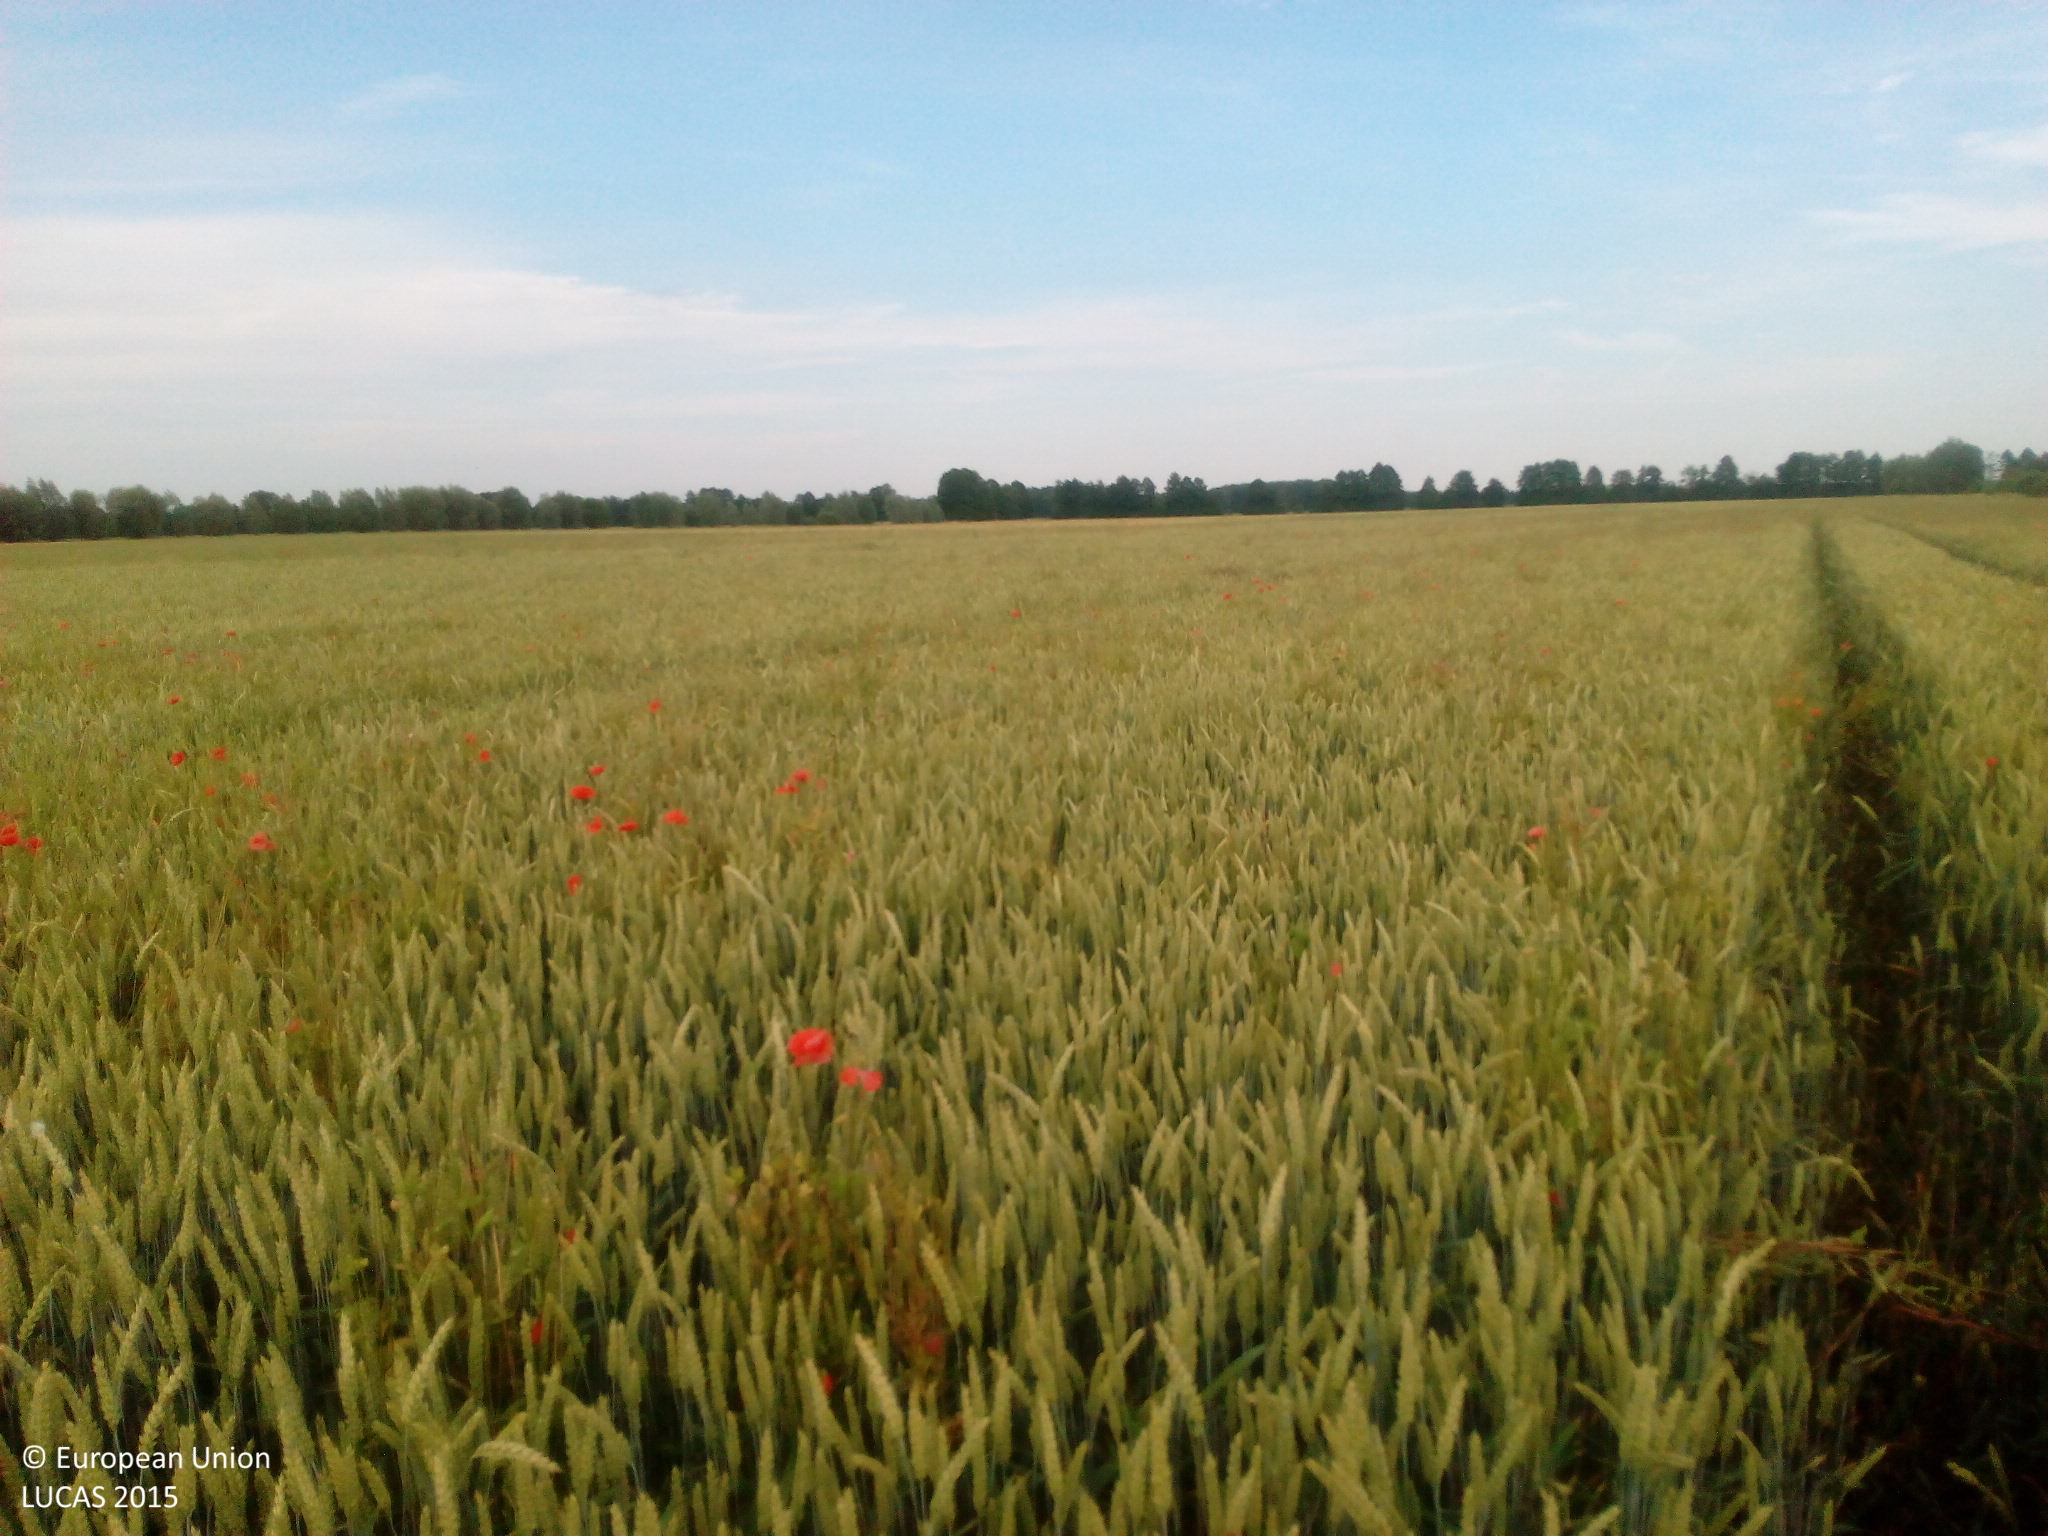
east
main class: Cropland
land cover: Common wheat
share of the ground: > 75 %
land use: Agriculture (excluding fallow land and kitchen gardens)
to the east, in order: Common wheat
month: July
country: DE
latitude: 52.8024
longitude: 12.4173
